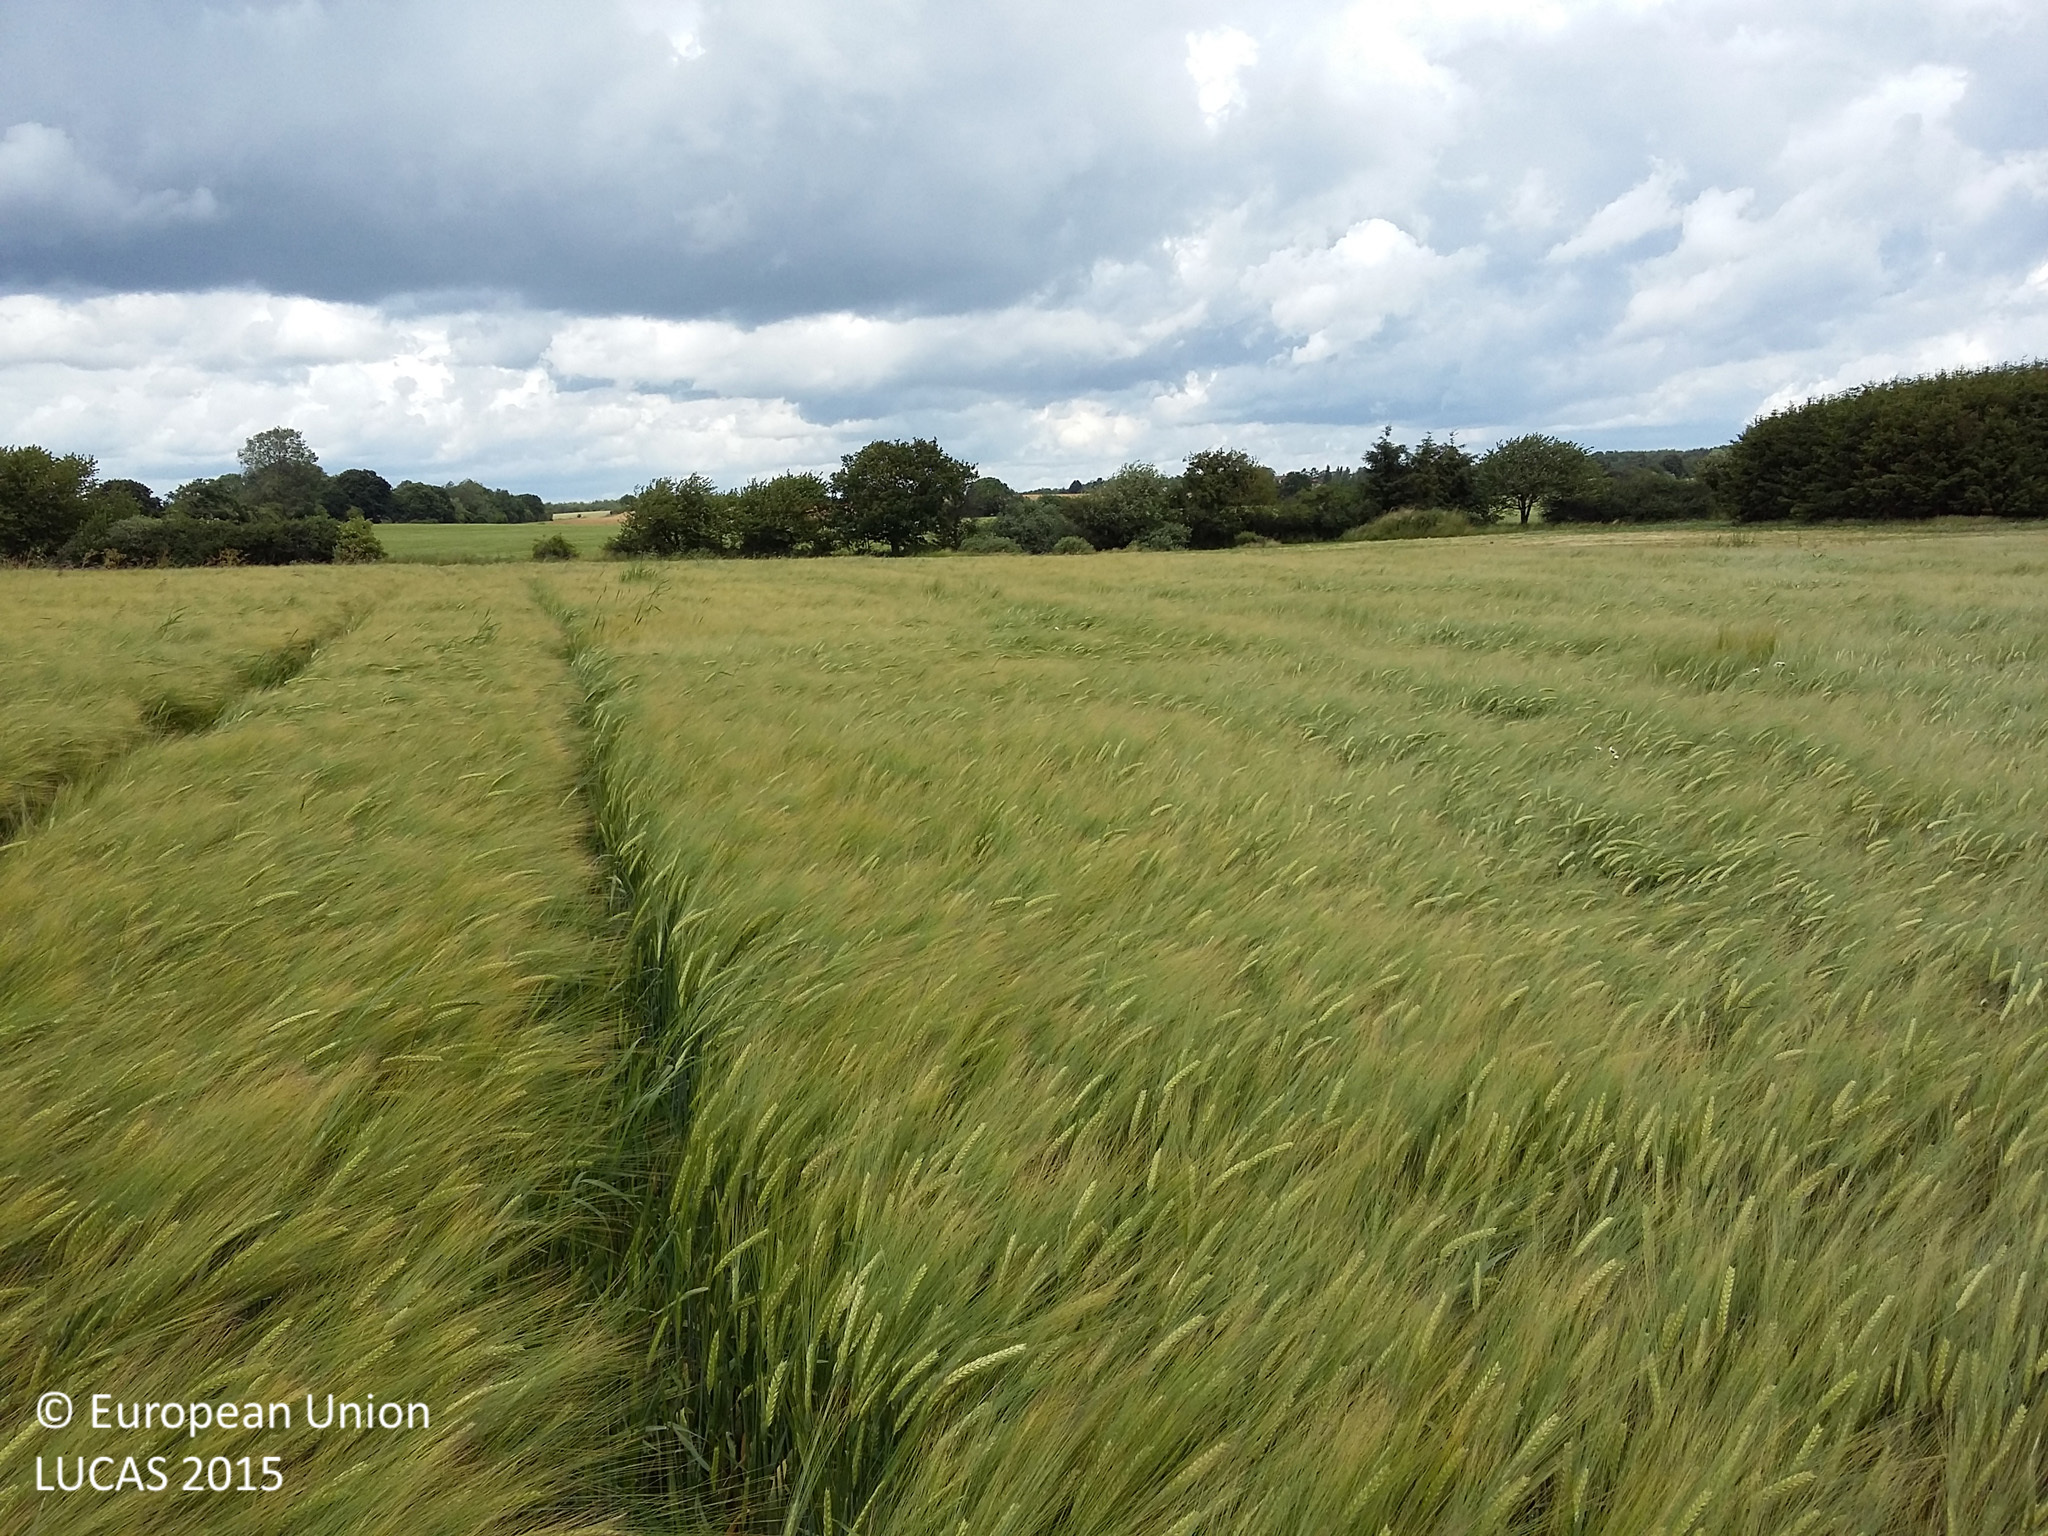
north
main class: Cropland
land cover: Barley
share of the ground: > 75 %
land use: Agriculture (excluding fallow land and kitchen gardens)
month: July
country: DK
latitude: 55.3864
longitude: 11.6245
